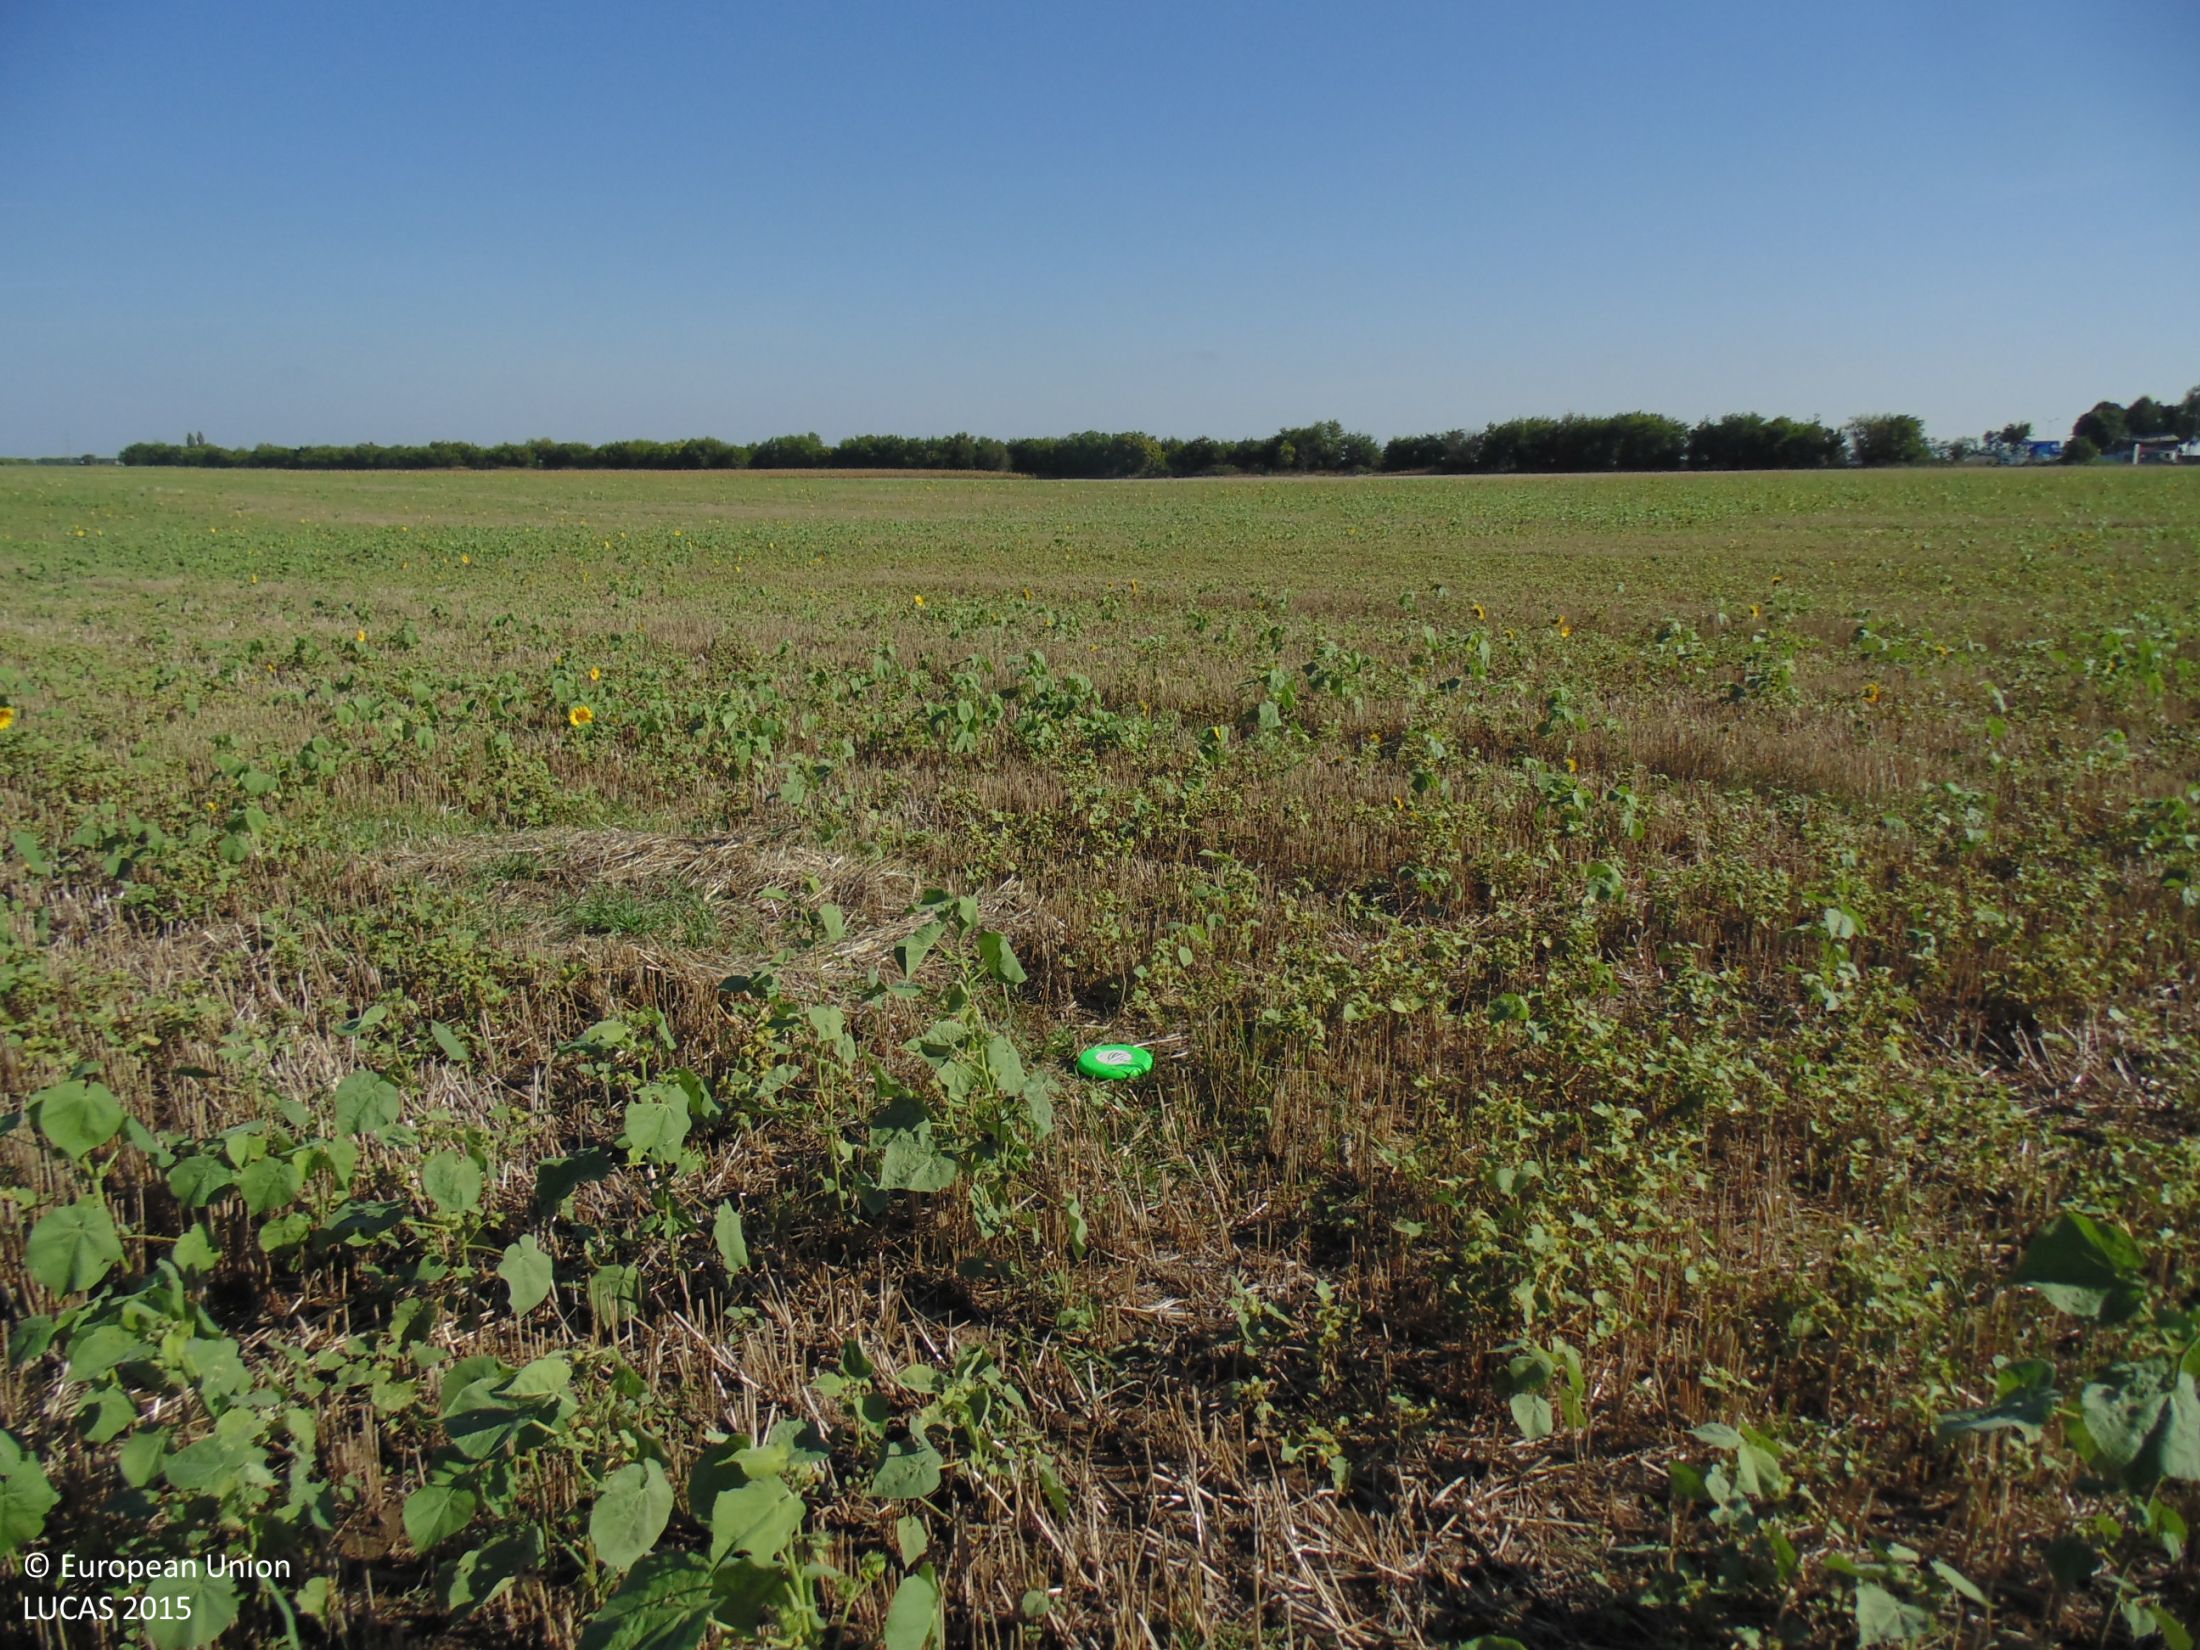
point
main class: Cropland
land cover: Common wheat
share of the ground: 10 - 25 %
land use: Agriculture (excluding fallow land and kitchen gardens)
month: September
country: BG
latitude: 44.0380
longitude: 27.0078
